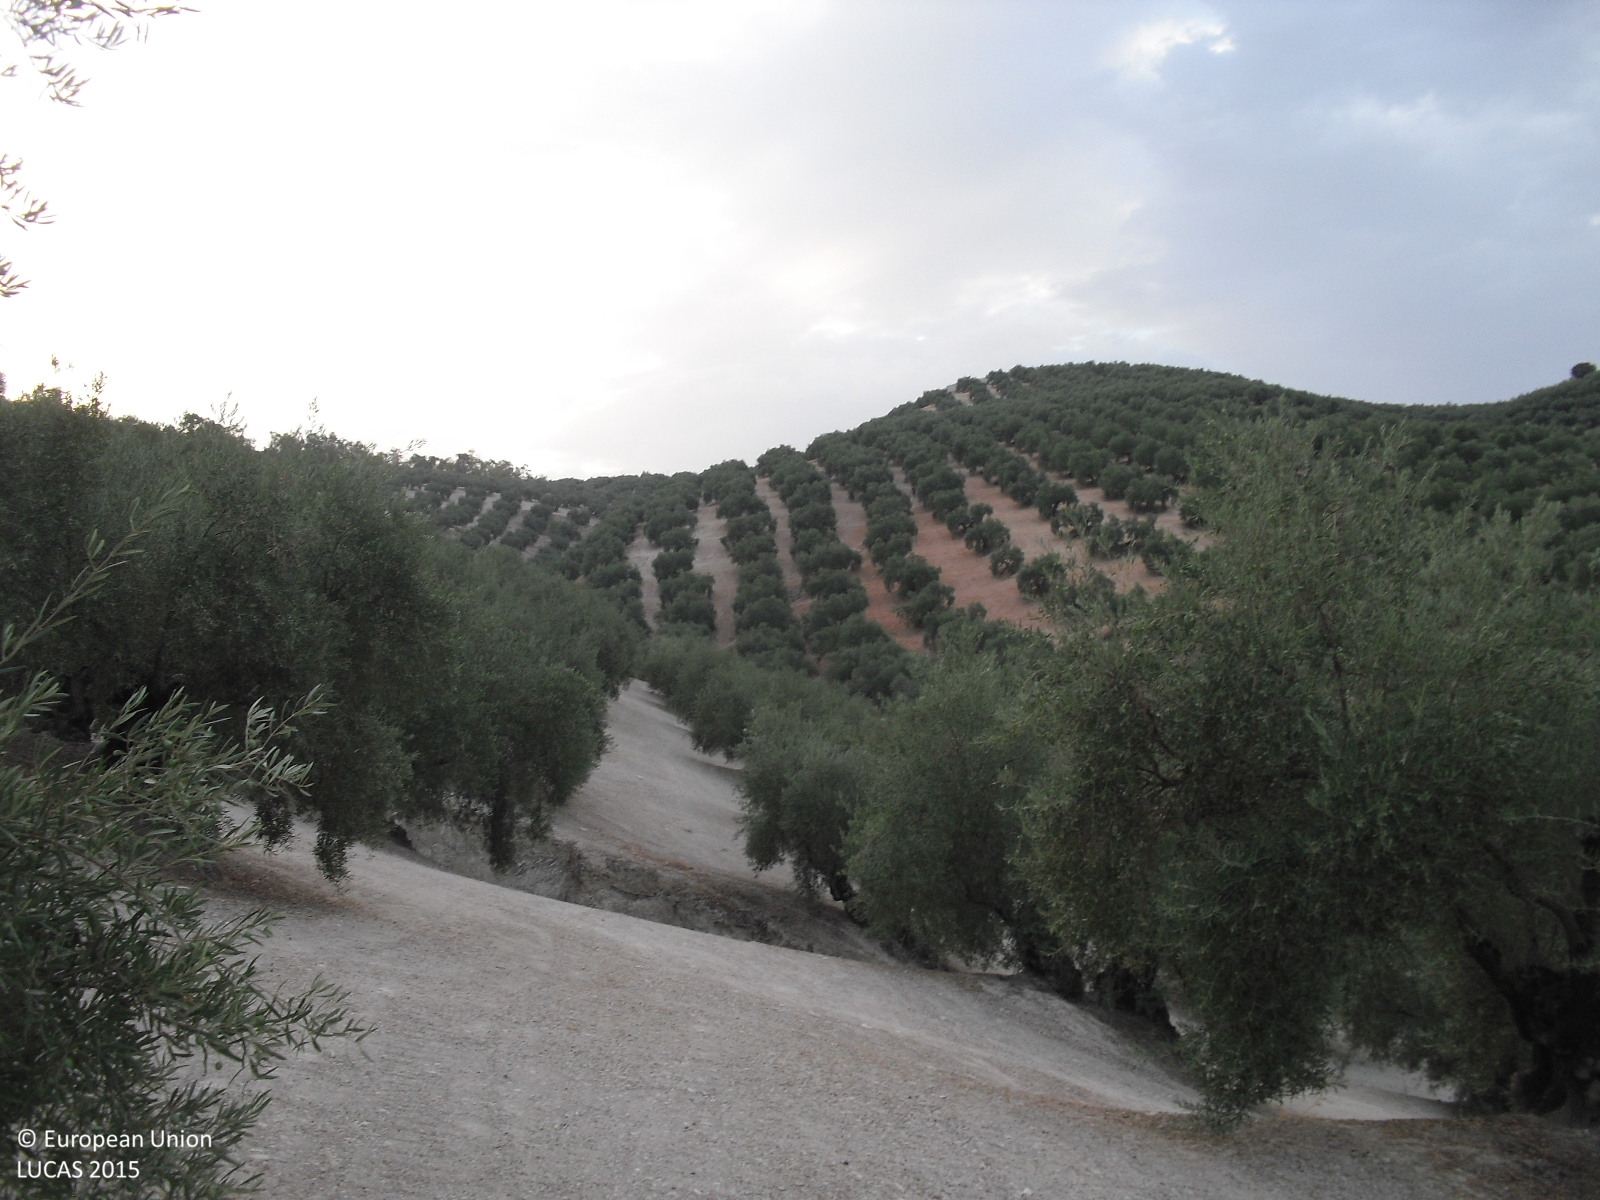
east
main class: Cropland
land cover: Olive groves
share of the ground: 25 - 50 %
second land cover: Other bare soil
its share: > 75 %
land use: Agriculture (excluding fallow land and kitchen gardens)
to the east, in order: Olive groves; Other bare soil; Other structural elements; Olive groves; Other structural elements; Olive groves
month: August
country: ES
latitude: 37.2984
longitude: -4.3374
